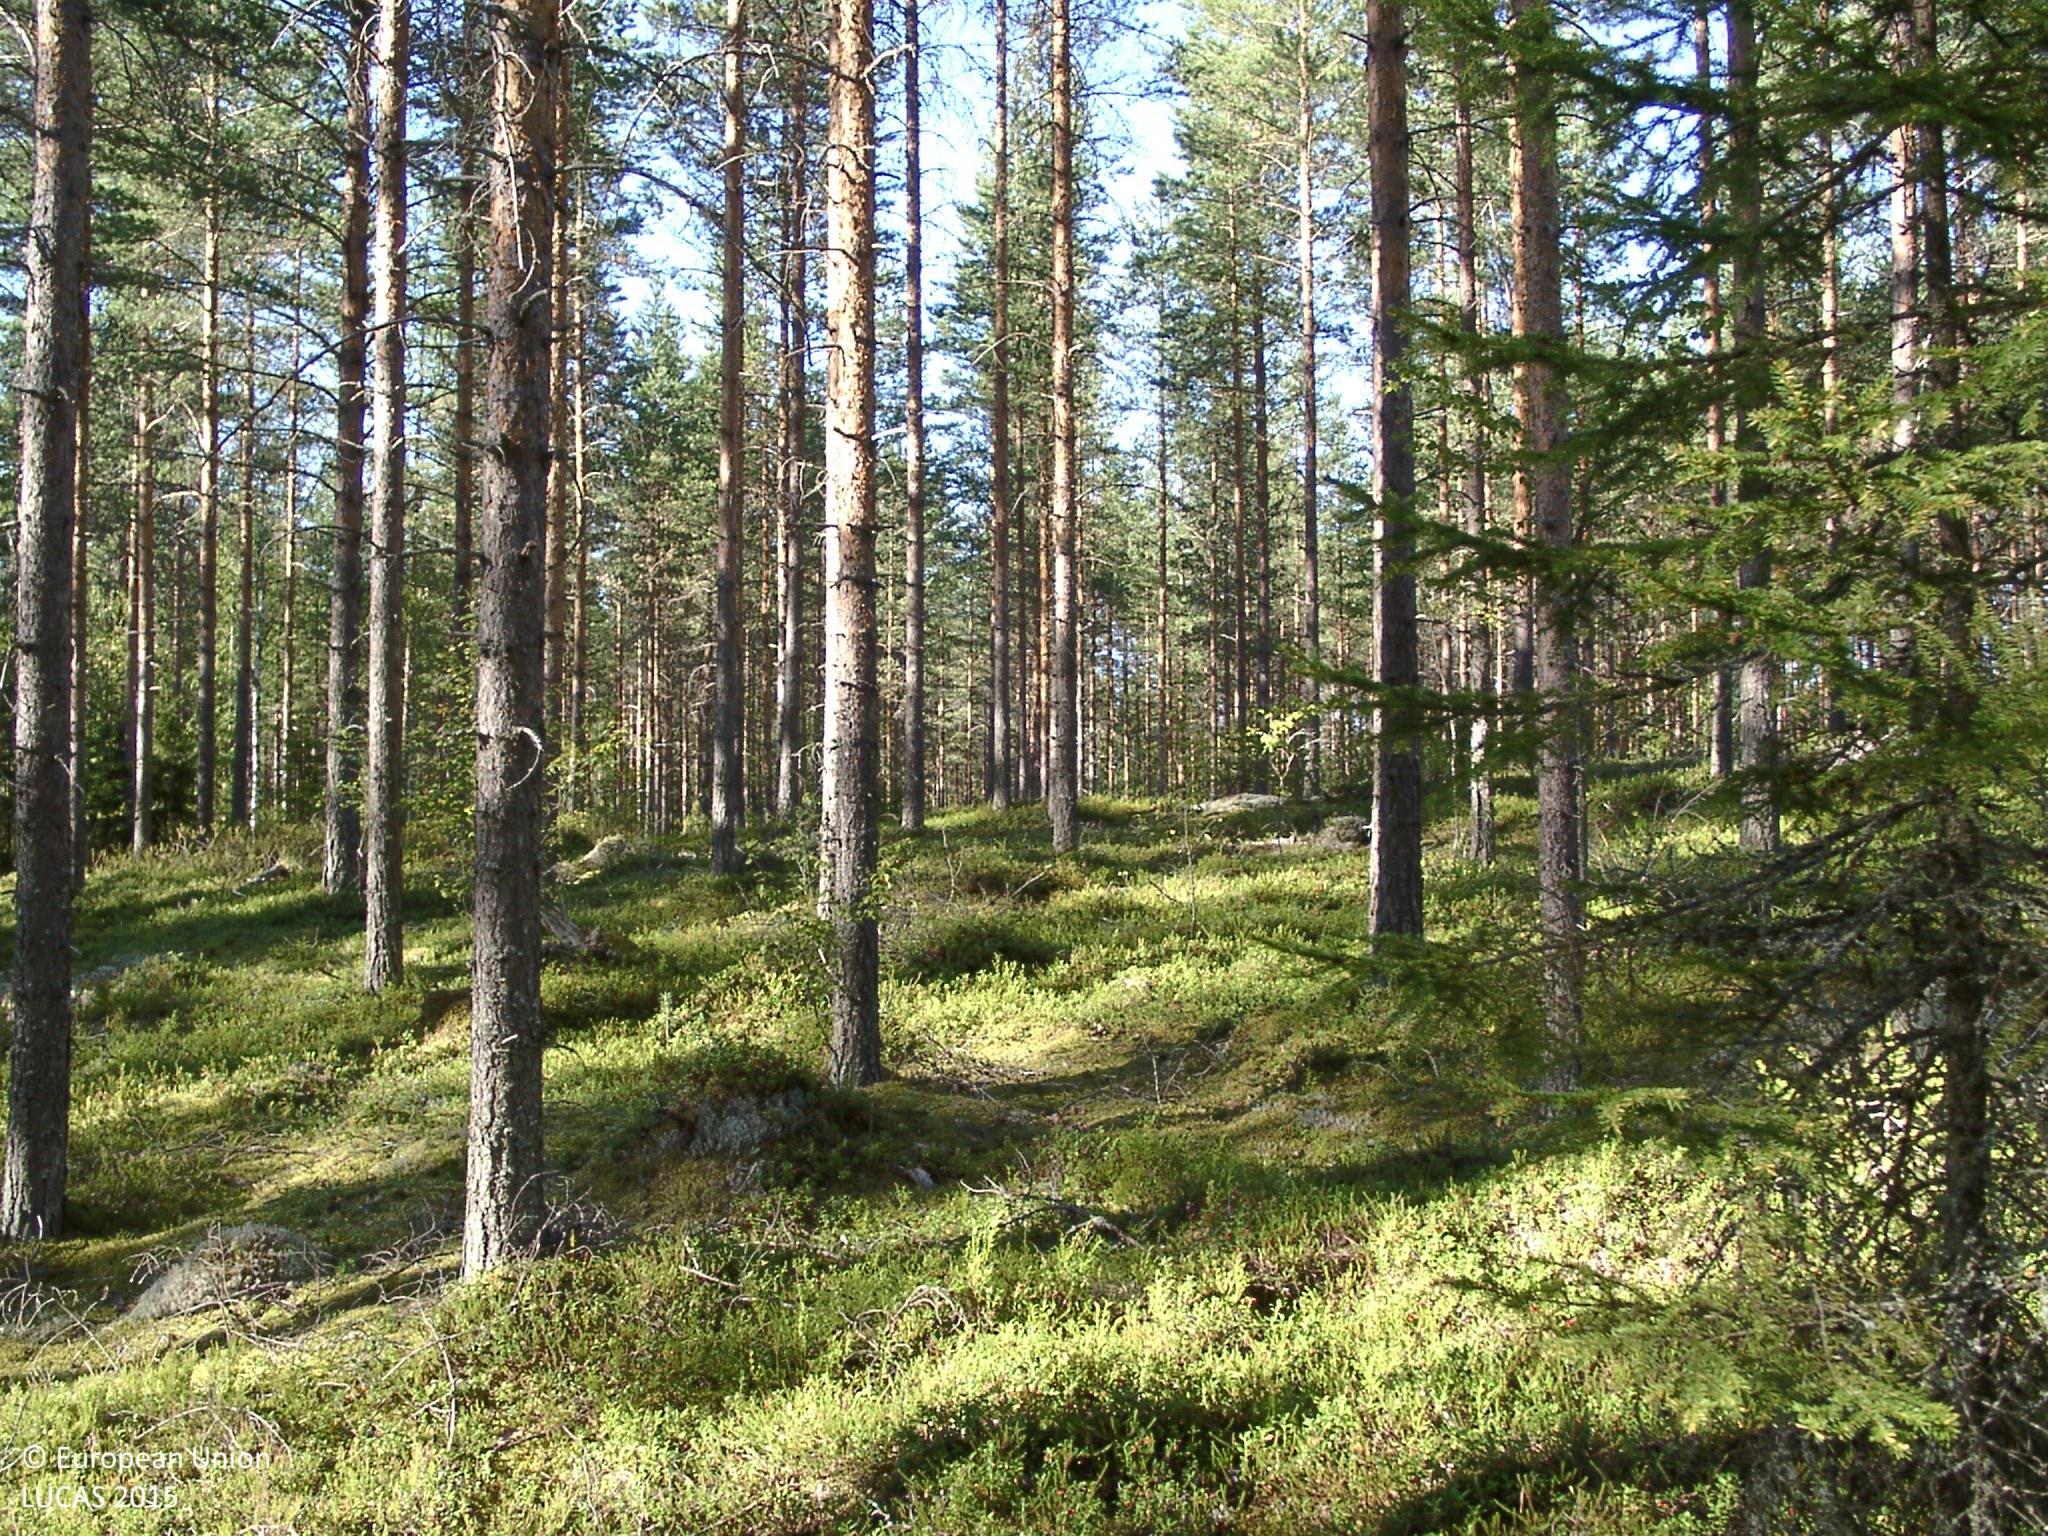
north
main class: Woodland
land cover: Pine dominated coniferous woodland
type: boreal forest
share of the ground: 50 - 75 %
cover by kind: coniferous forest trees 65 %, shrubs 20 %, lichens and mosses 15 %
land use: Forestry
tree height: > 5 m
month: August
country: FI
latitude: 62.4443
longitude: 25.3582
